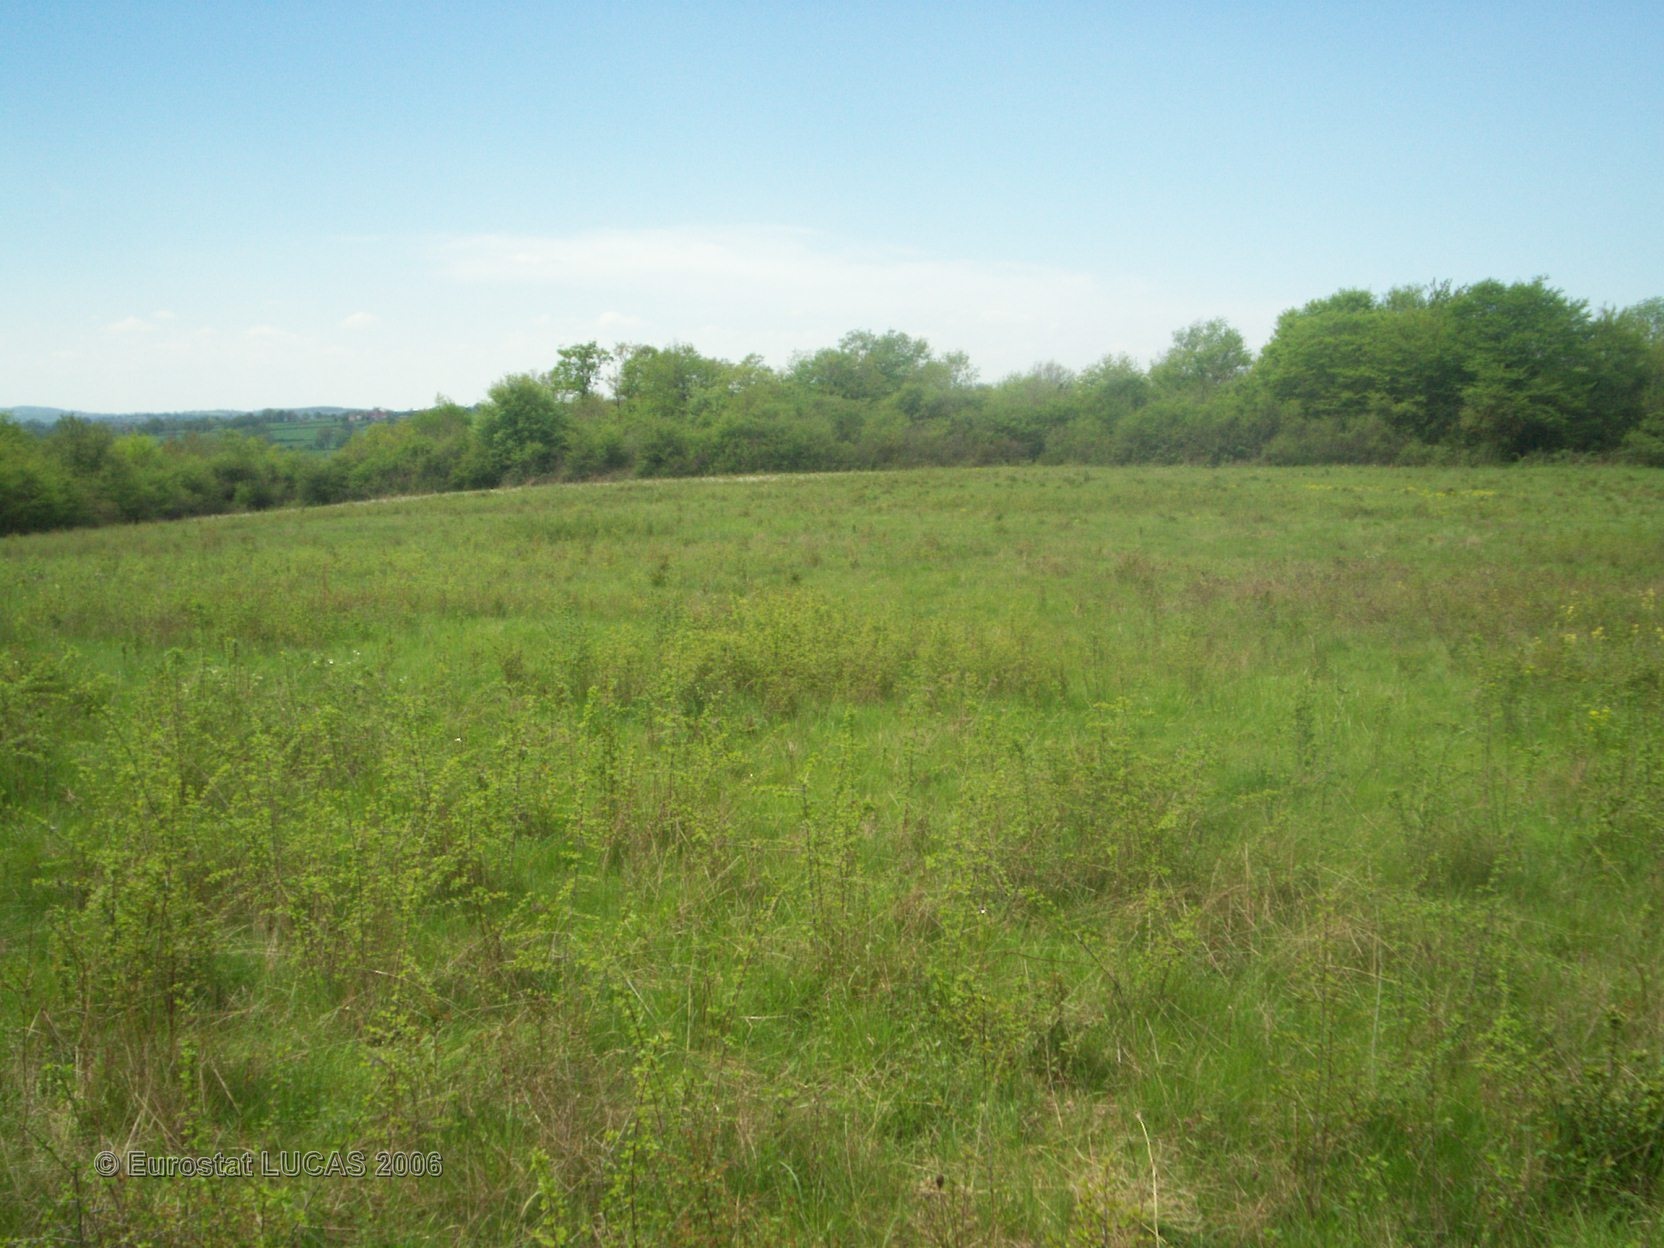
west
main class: Grassland
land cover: Grassland with sparse tree/shrub cover
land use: Unused
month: May
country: FR
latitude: 46.2734
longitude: 3.1077
